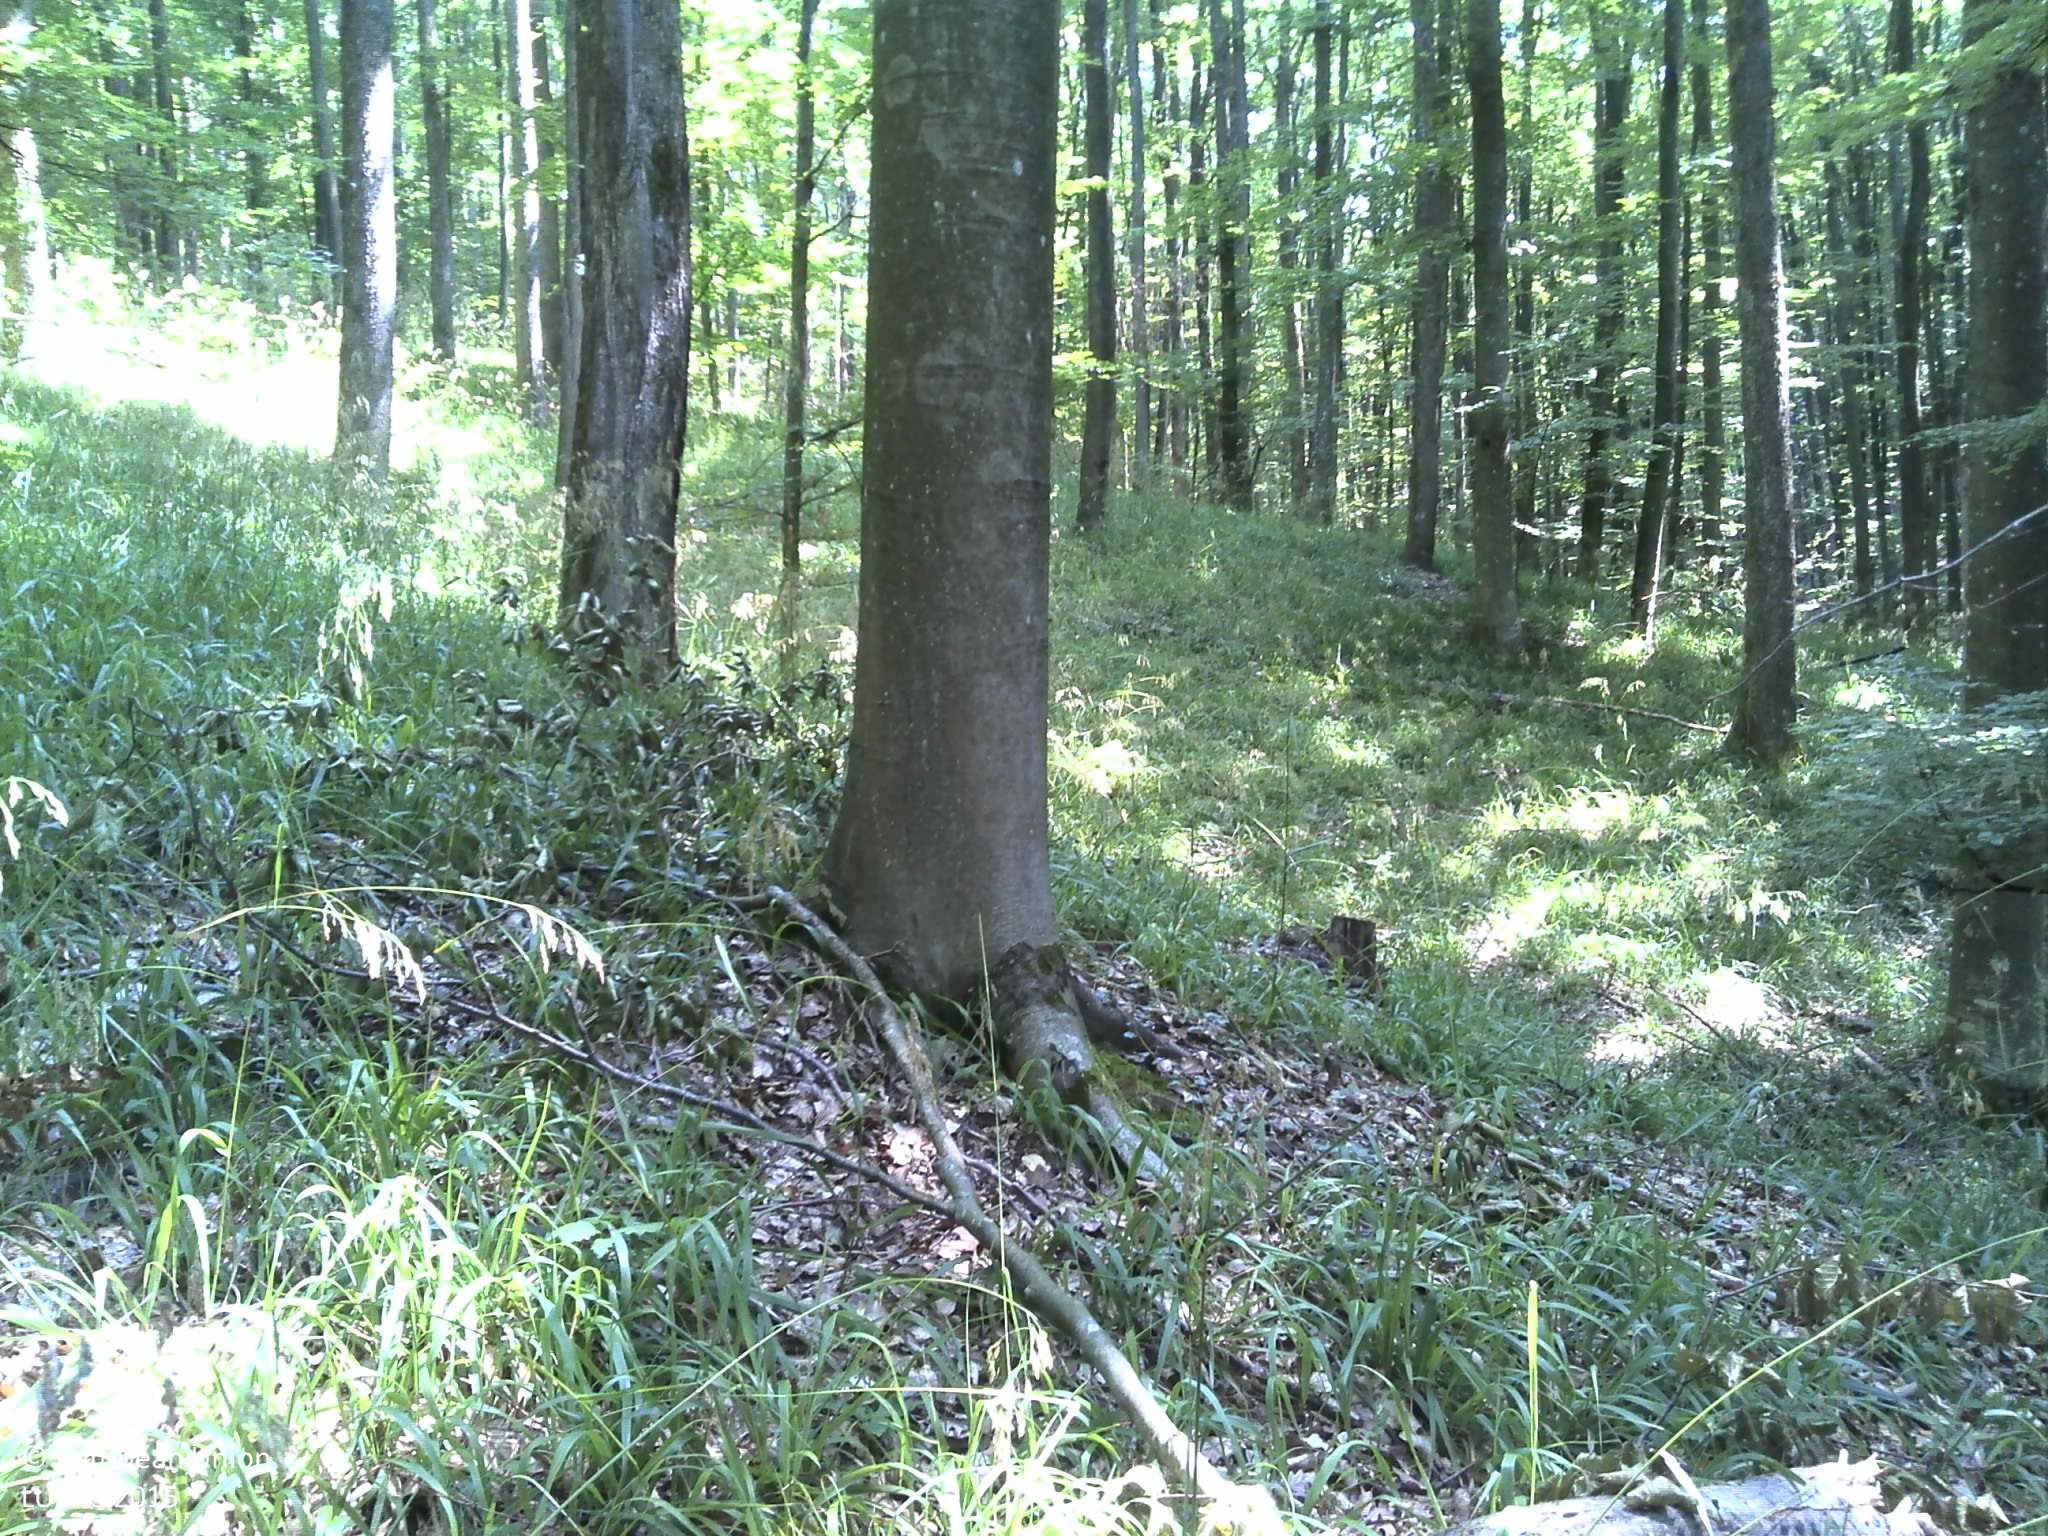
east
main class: Woodland
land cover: Broadleaved woodland
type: acidophilous oak and oak-birch forest
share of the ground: > 75 %
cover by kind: broadleaved forest trees 90 %, shrubs 5 %, herbaceous plants 5 %
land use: Forestry
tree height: > 5 m
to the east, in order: Broadleaved woodland; Ditches and canals; Tracks; Broadleaved woodland
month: July
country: HR
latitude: 45.6752
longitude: 16.6361
